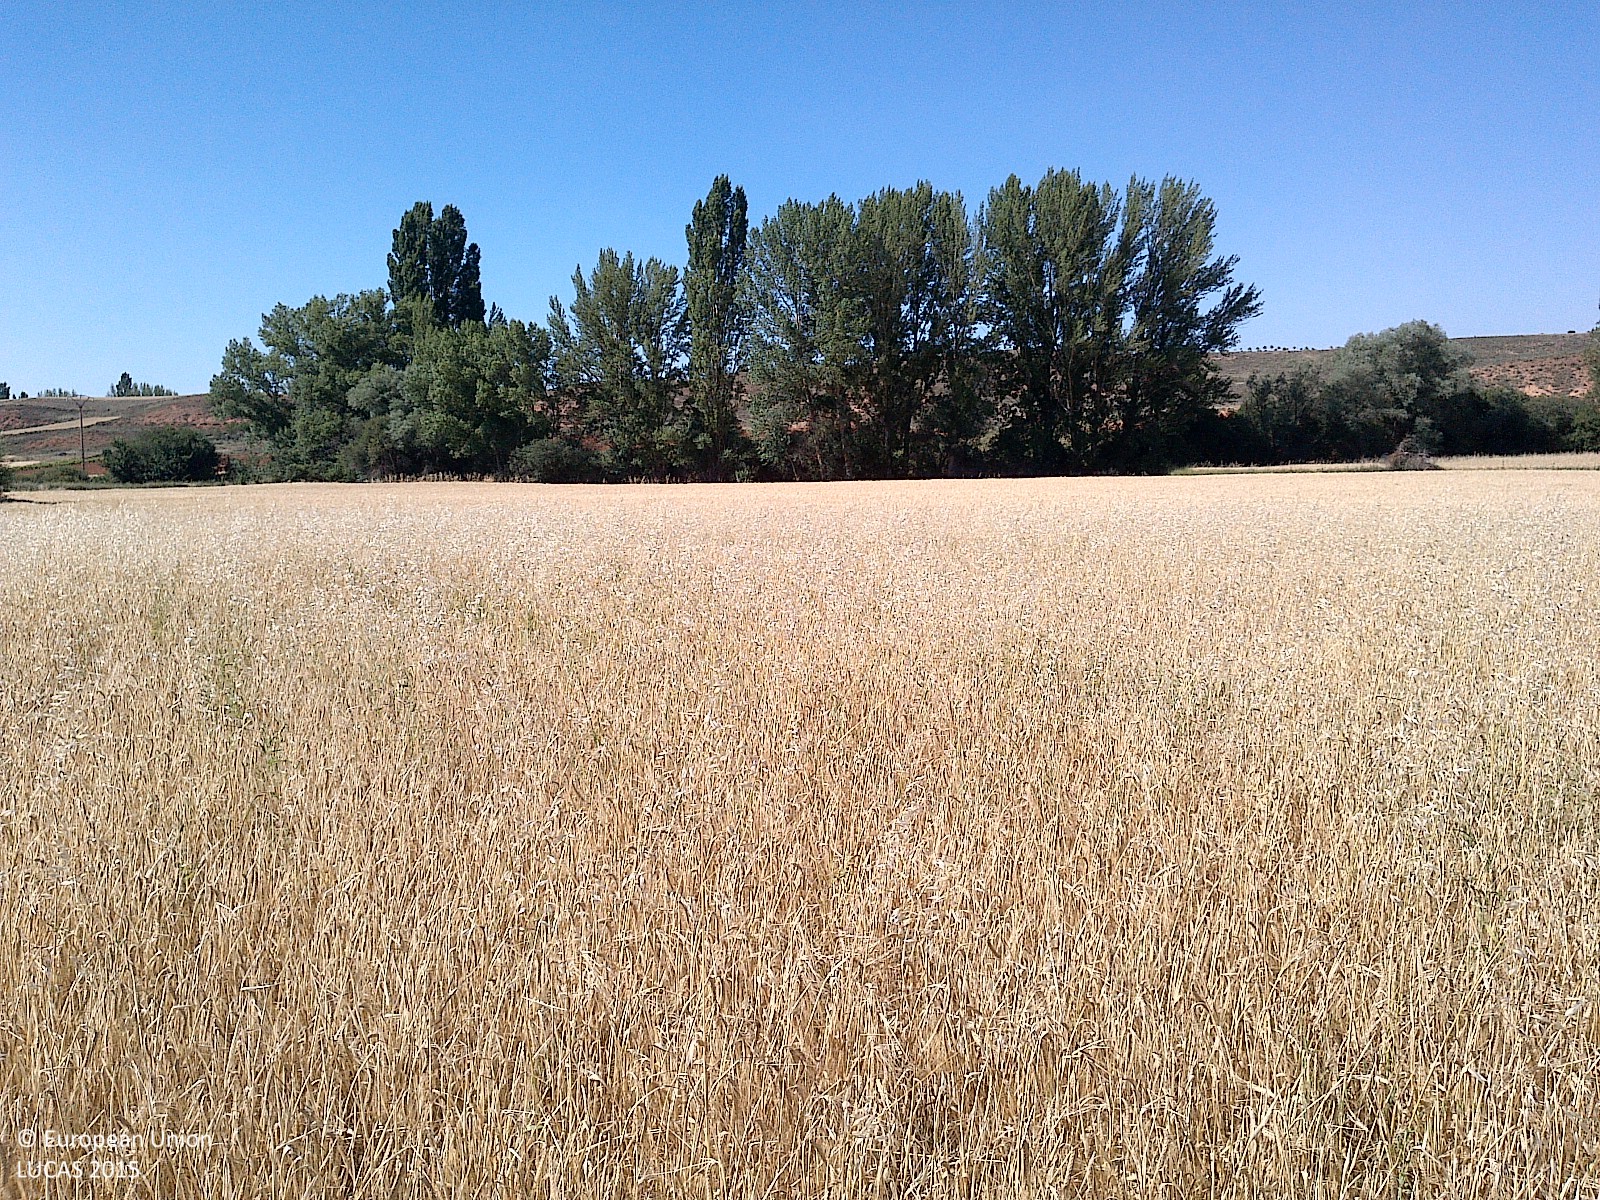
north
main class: Cropland
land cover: Barley
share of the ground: > 75 %
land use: Agriculture (excluding fallow land and kitchen gardens)
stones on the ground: < 10 %
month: July
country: ES
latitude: 41.6377
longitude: -3.2152
